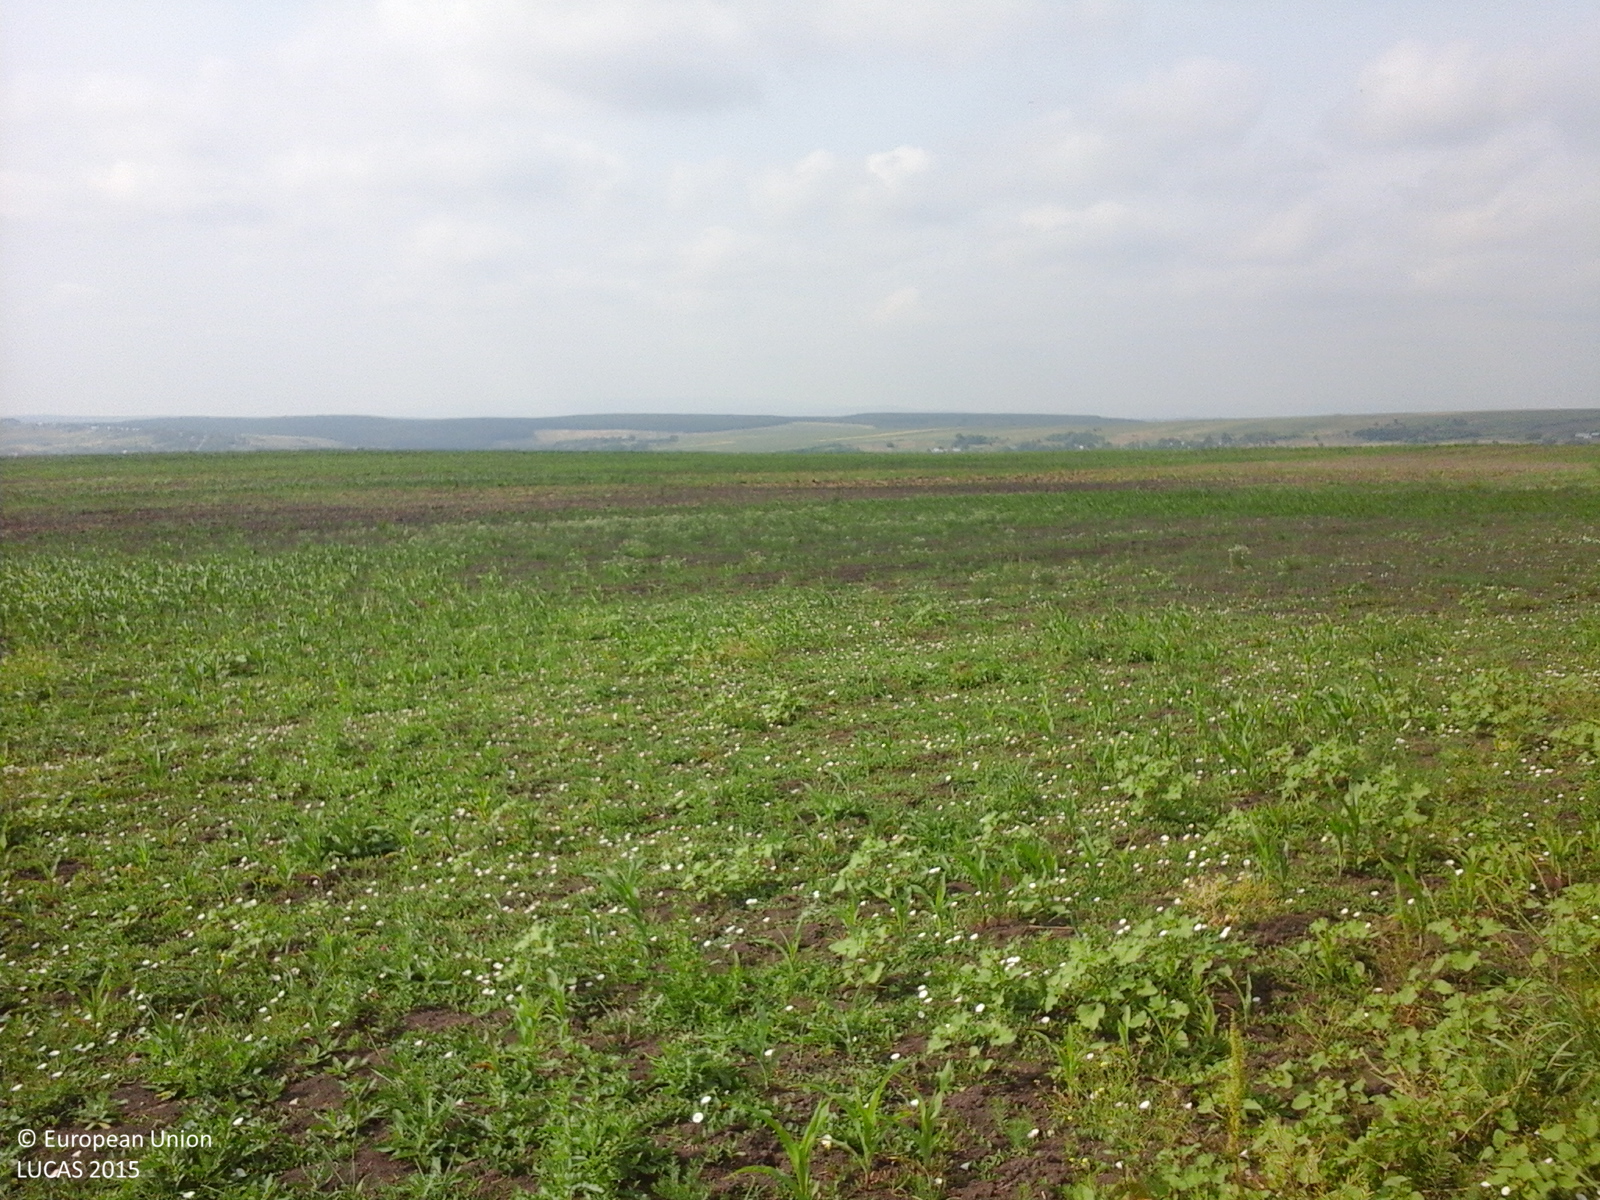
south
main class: Cropland
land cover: Maize
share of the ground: 25 - 50 %
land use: Agriculture (excluding fallow land and kitchen gardens)
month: June
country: RO
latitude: 47.7174
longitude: 26.8839
